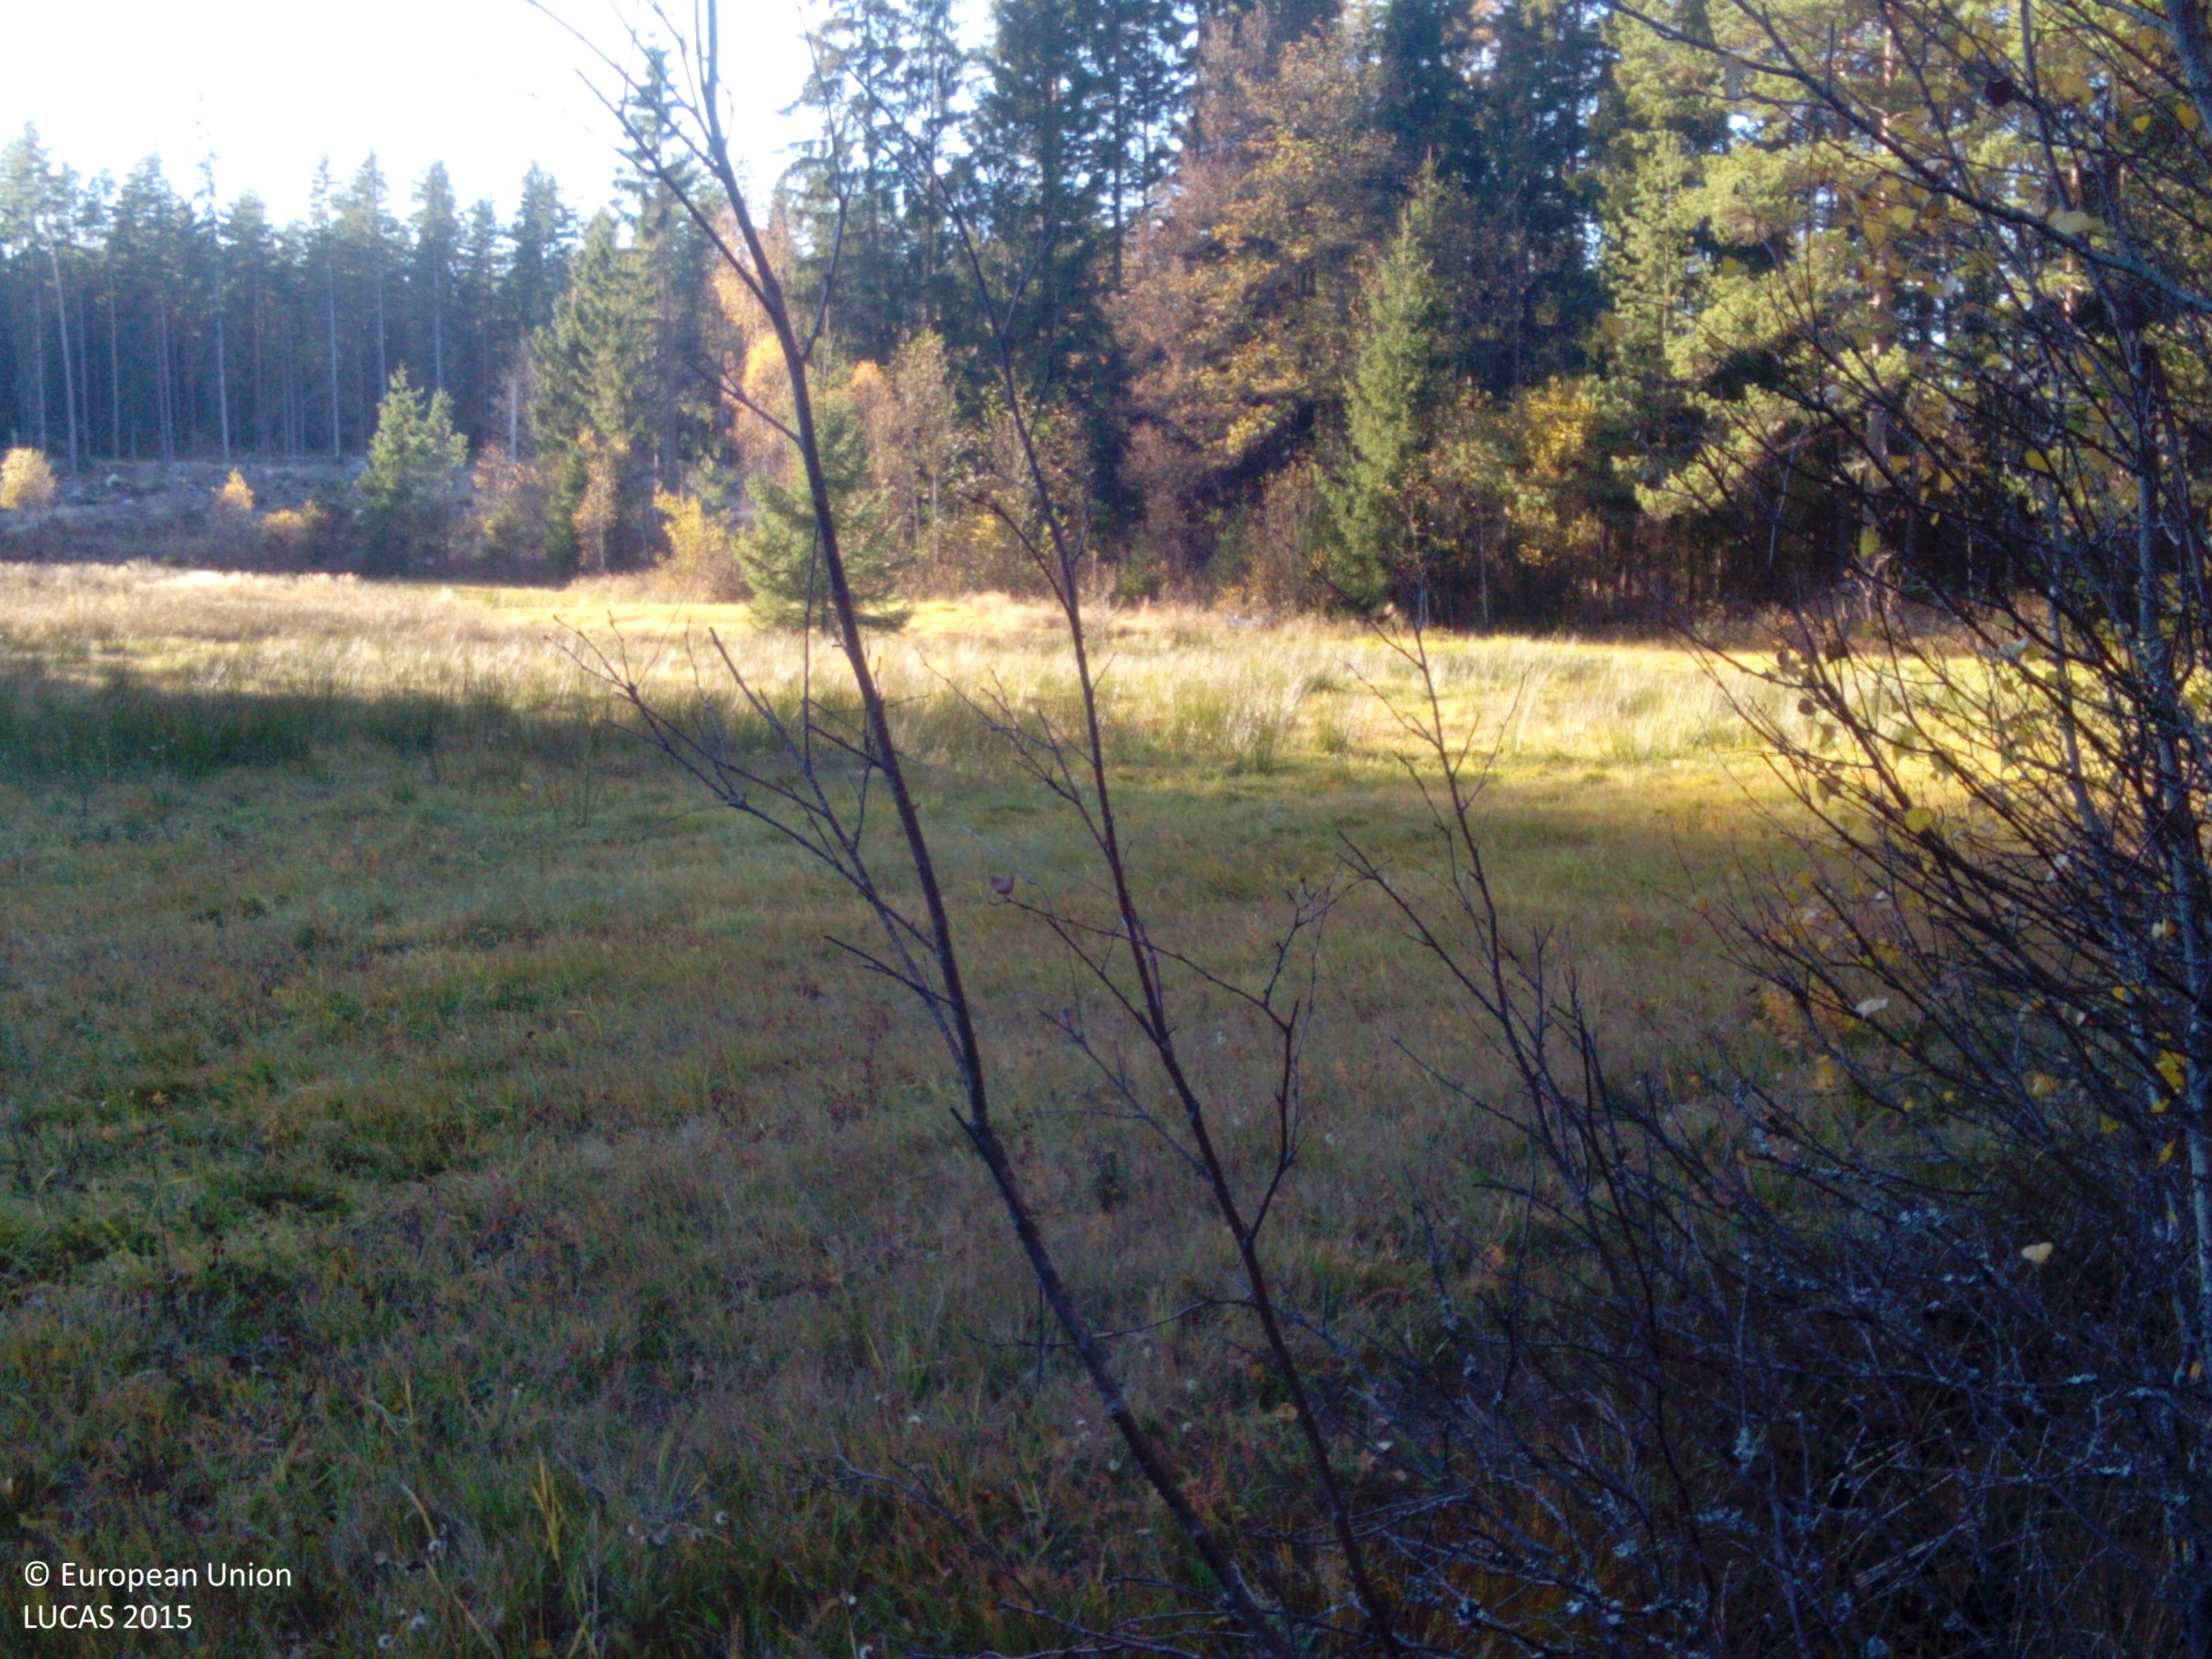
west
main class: Woodland
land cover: Pine dominated coniferous woodland
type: boreal forest
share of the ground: 25 - 50 %
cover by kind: herbaceous plants 55 %, coniferous forest trees 40 %, broadleaved forest trees 5 %
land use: Forestry
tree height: > 5 m
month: October
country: SE
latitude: 59.1303
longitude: 16.4415
